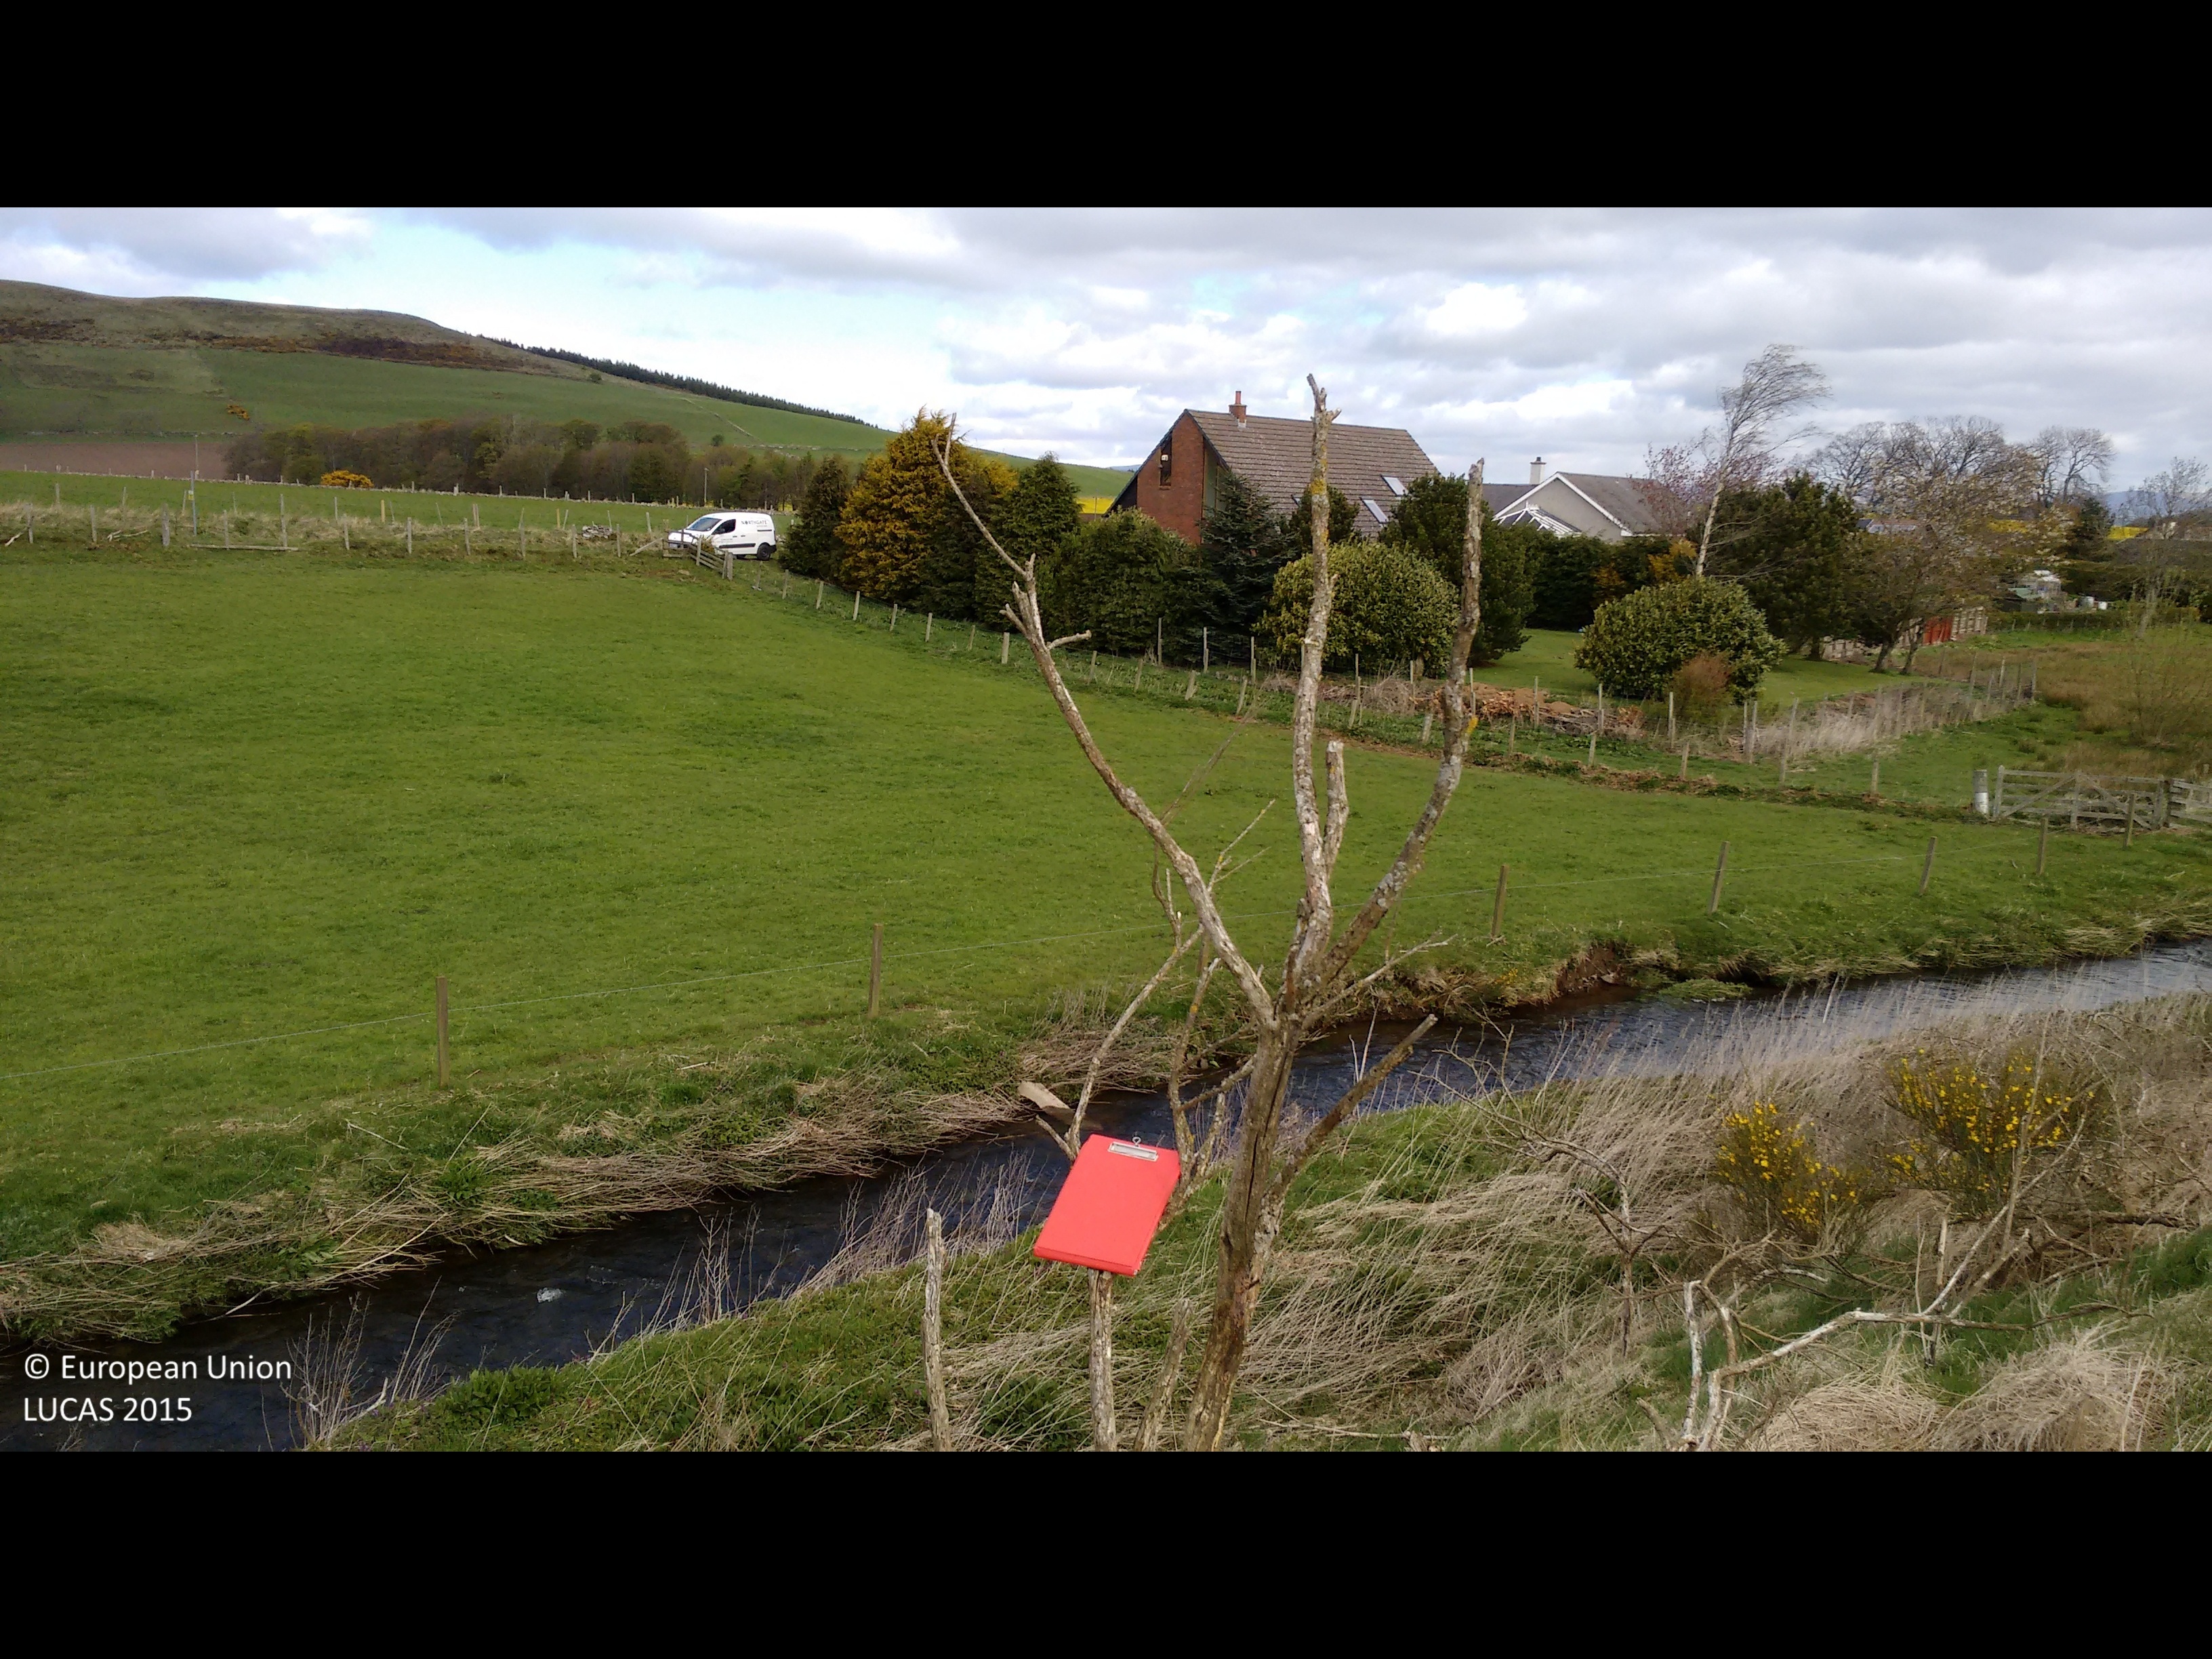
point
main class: Shrubland
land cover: Shrubland without tree cover
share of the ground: 50 - 75 %
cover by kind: herbaceous plants 60 %, shrubs 40 %
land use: Semi-natural and natural areas not in use
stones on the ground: 10 - 25 %
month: May
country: GB
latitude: 56.5800
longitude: -3.0079
